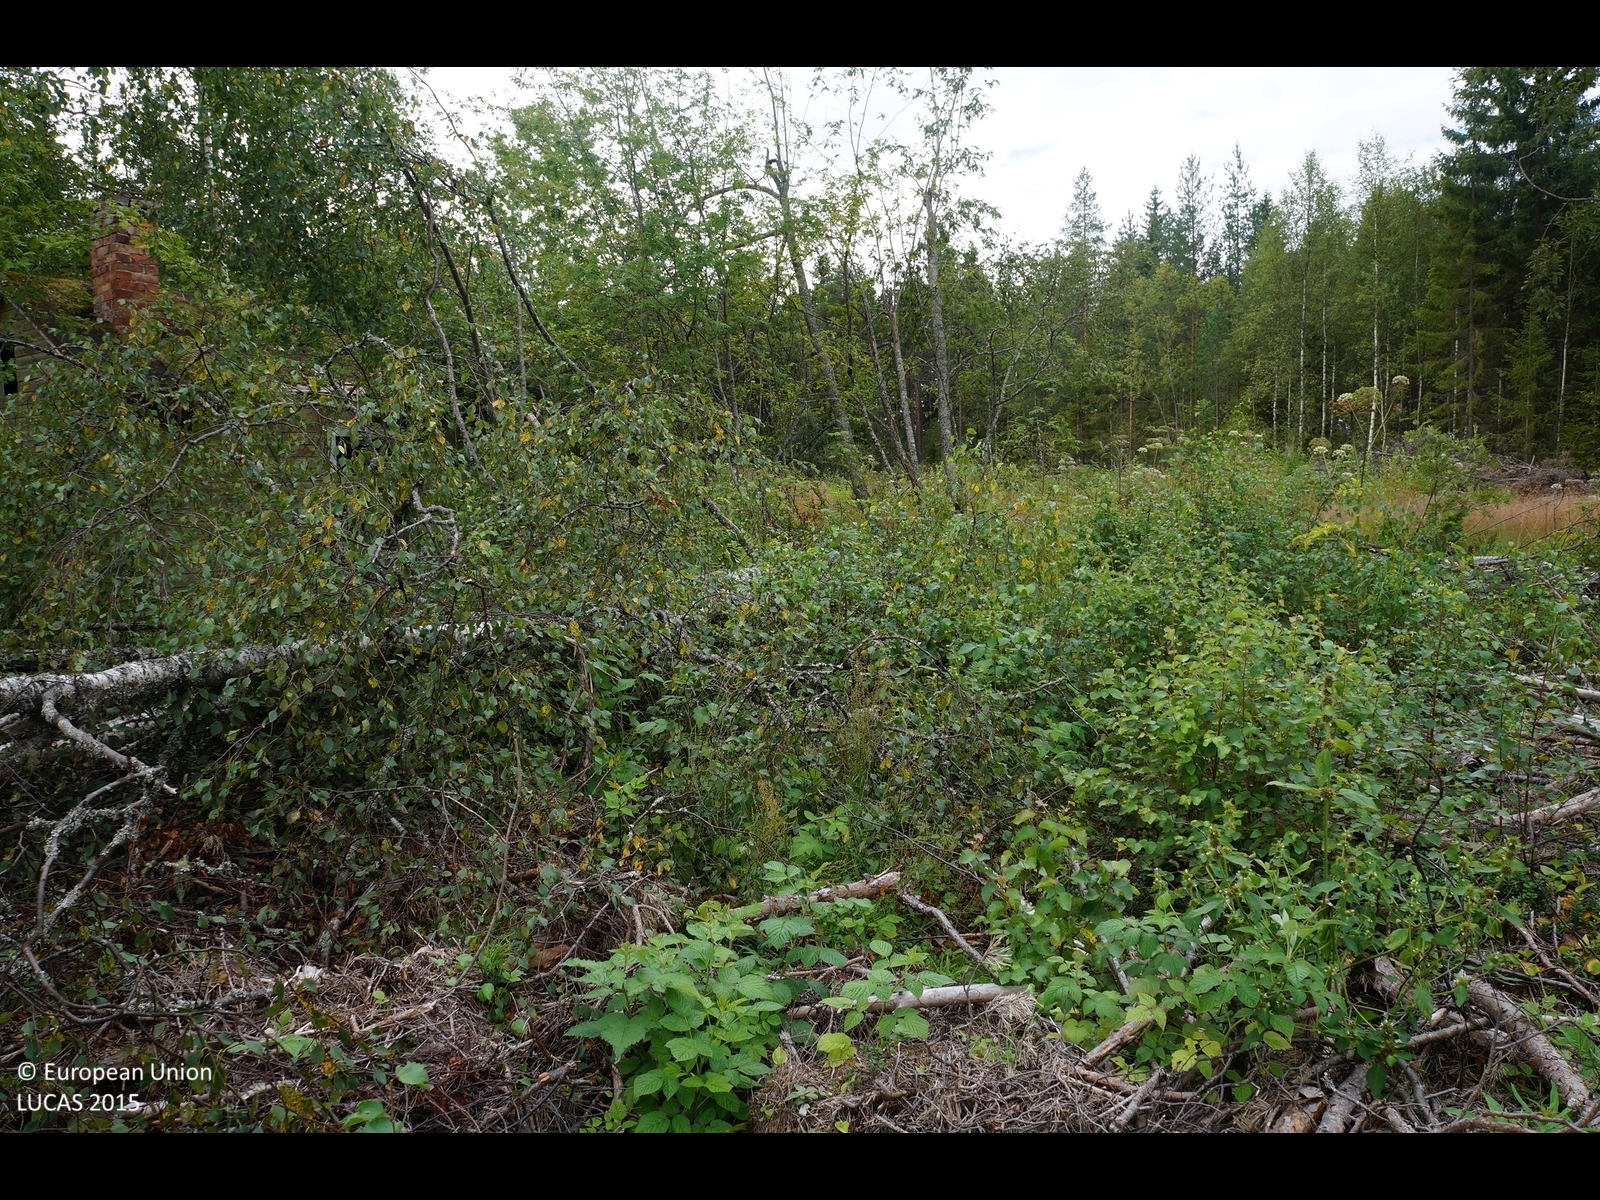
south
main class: Shrubland
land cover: Shrubland without tree cover
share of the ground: 25 - 50 %
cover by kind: shrubs 35 %, herbaceous plants 20 %, unconsolidated bare surface 10 %
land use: Forestry
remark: Clear cut
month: August
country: FI
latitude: 64.7879
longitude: 25.3799
